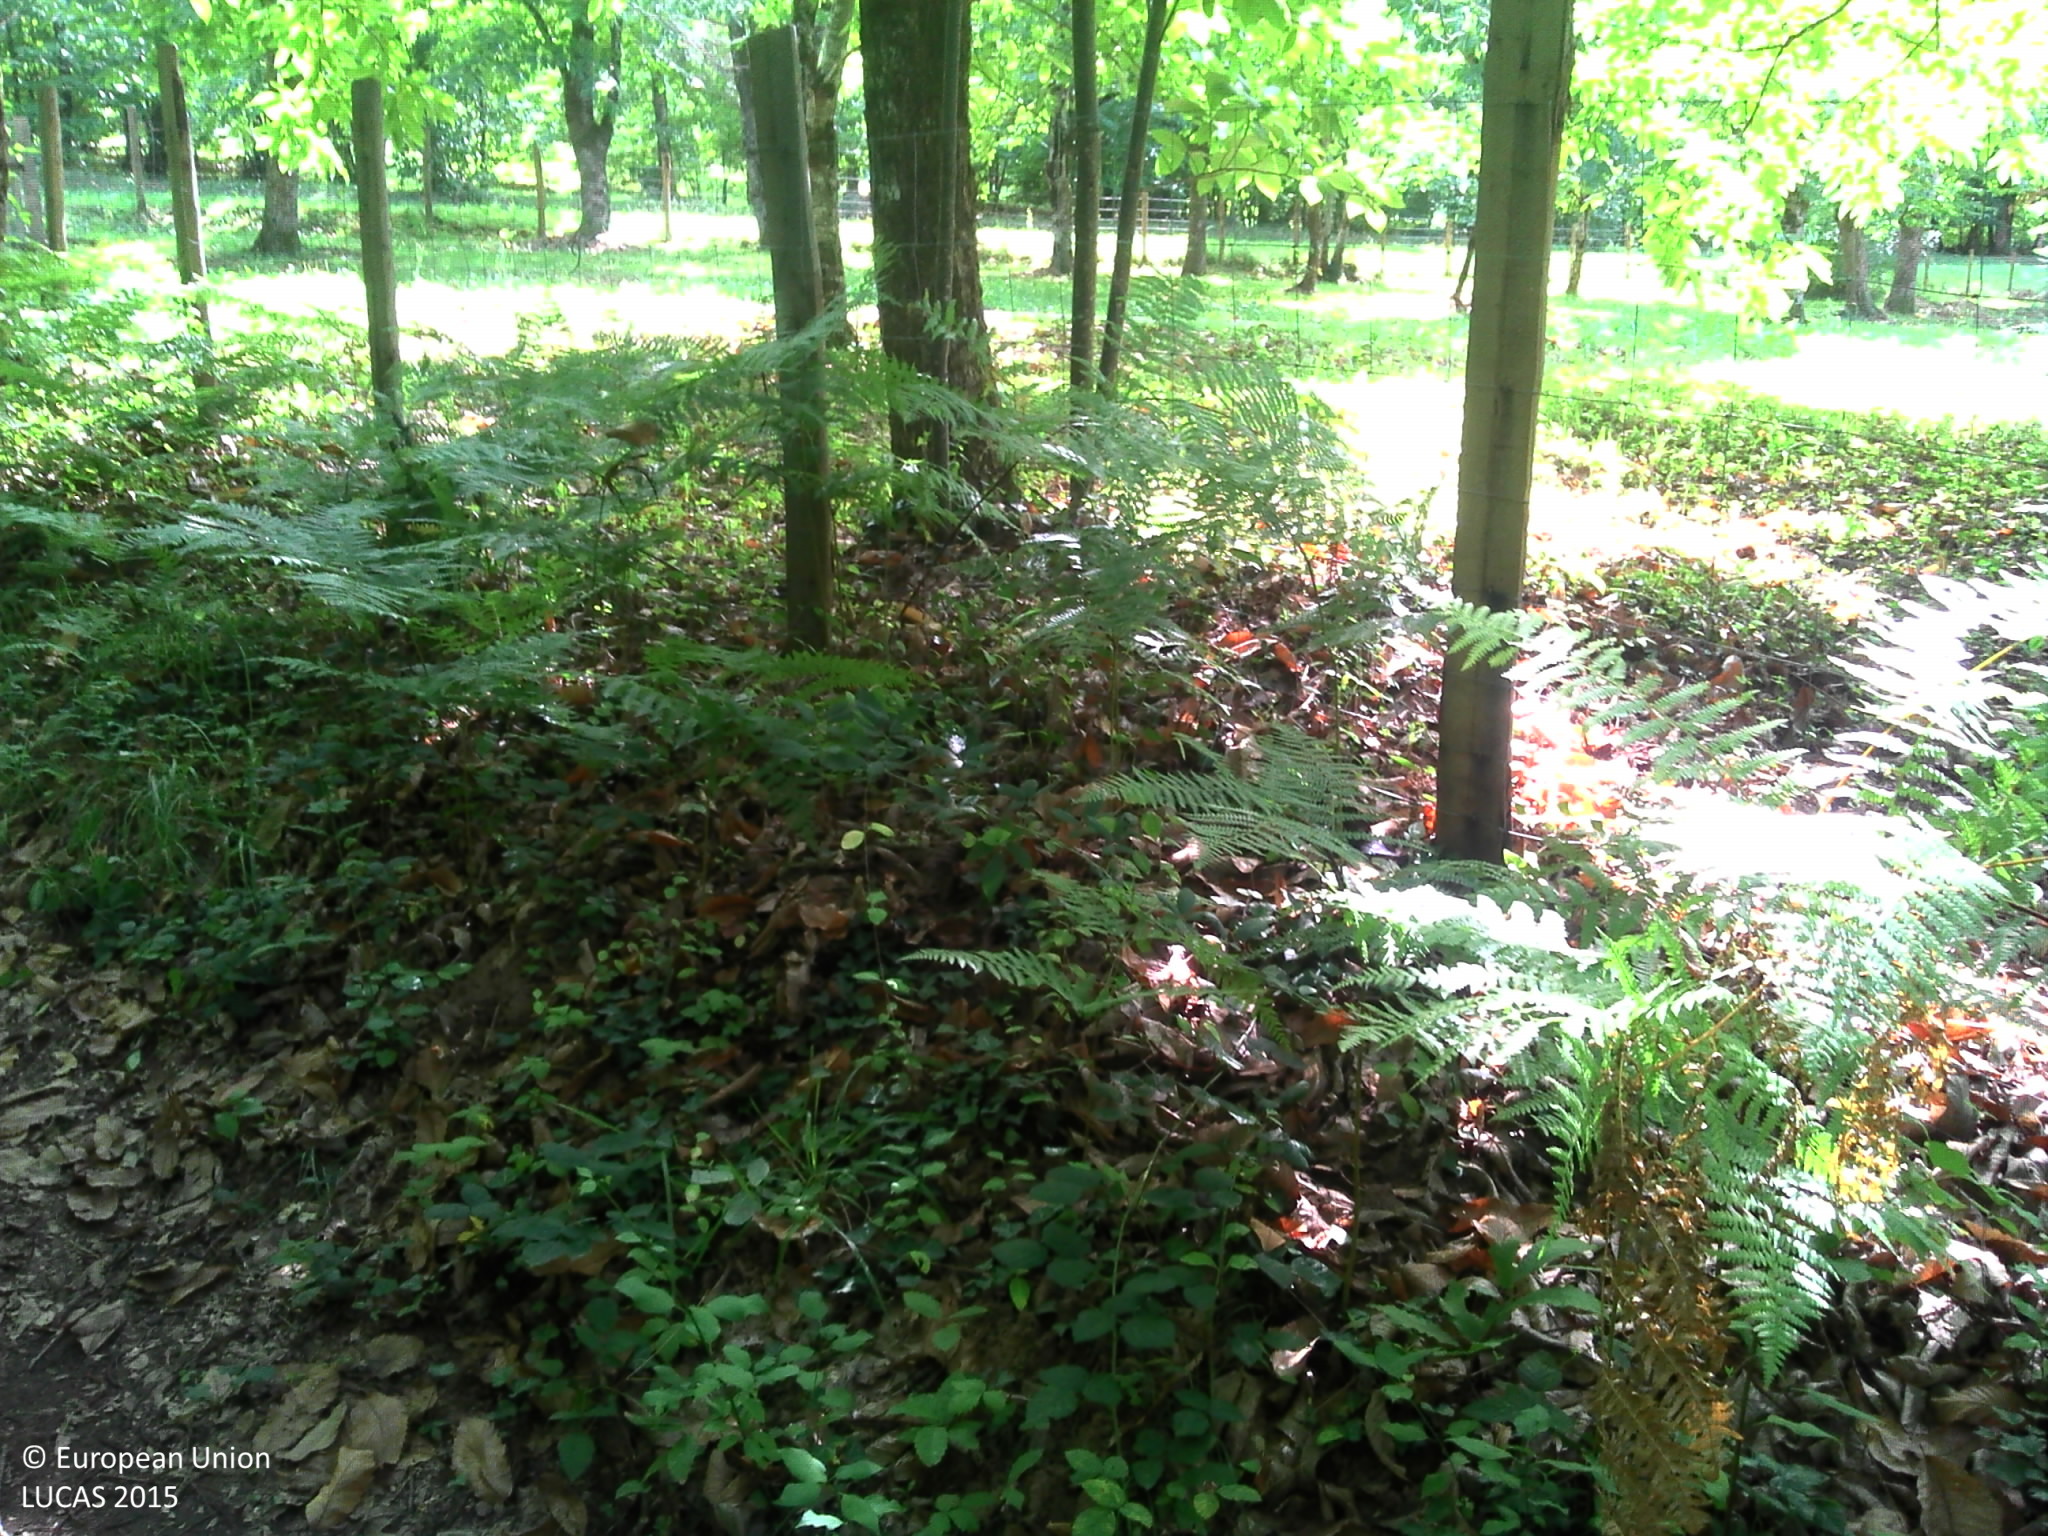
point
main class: Woodland
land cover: Broadleaved woodland
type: thermophilous deciduous forest
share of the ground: > 75 %
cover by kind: broadleaved forest trees 80 %, herbaceous plants 20 %
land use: Residential
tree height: > 5 m
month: August
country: FR
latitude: 44.5539
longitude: 1.1716
